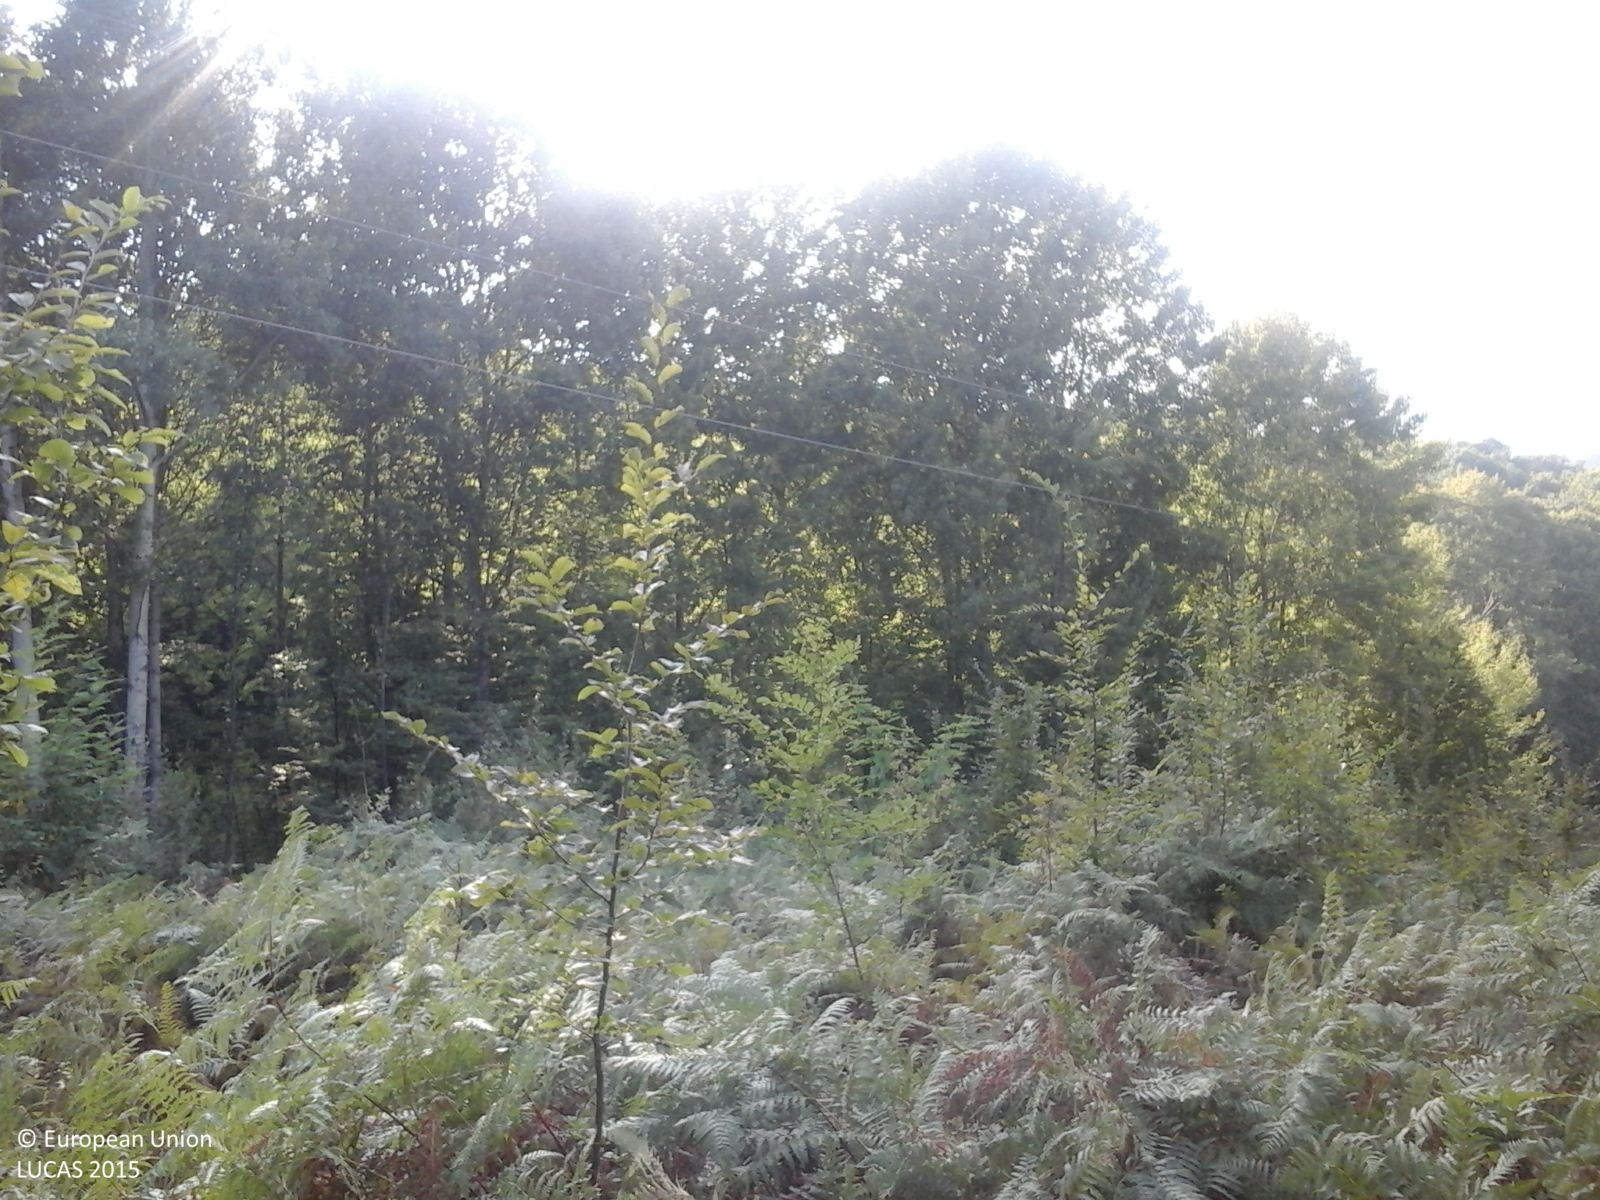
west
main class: Shrubland
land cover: Shrubland with sparse tree cover
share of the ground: > 75 %
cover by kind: shrubs 95 %, broadleaved forest trees 5 %
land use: Semi-natural and natural areas not in use
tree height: < 5 m
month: September
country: RO
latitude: 45.0866
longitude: 22.9447
